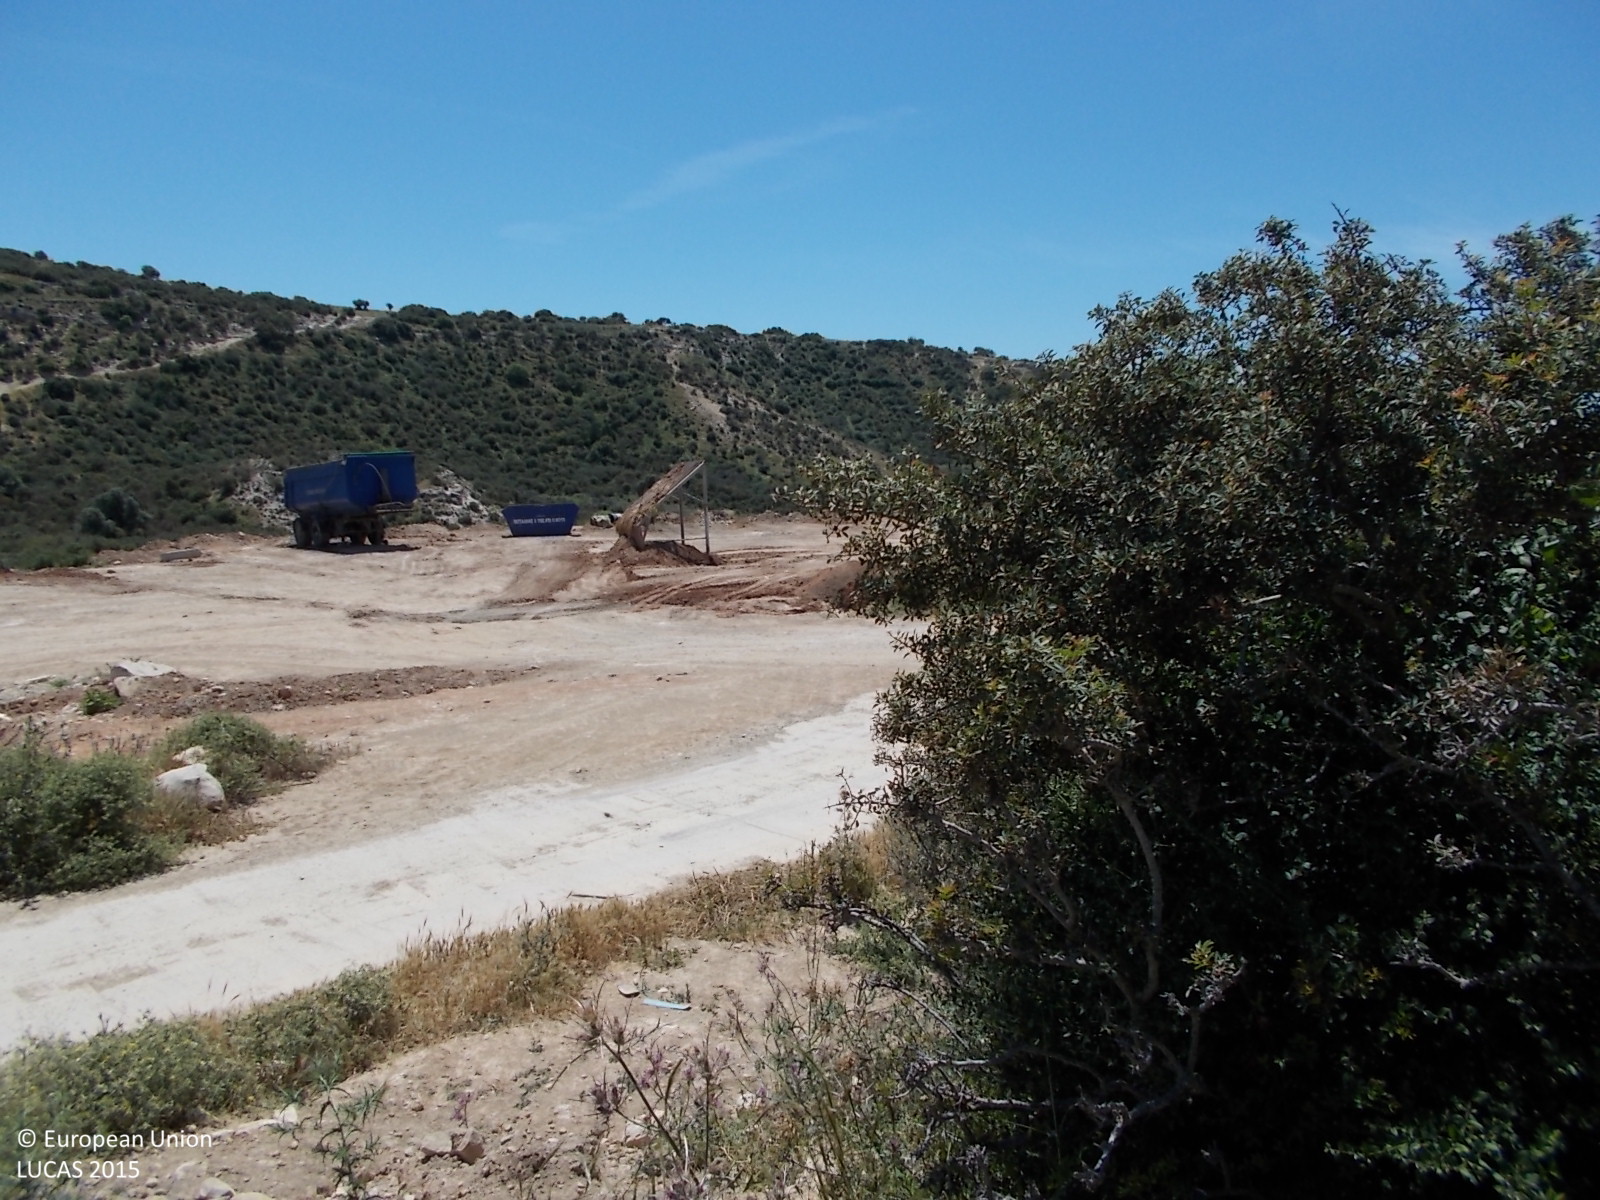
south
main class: Shrubland
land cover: Shrubland without tree cover
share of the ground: > 75 %
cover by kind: shrubs 75 %, herbaceous plants 15 %, unconsolidated bare surface 10 %
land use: Agriculture (excluding fallow land and kitchen gardens)
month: April
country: CY
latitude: 34.7274
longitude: 33.1134
